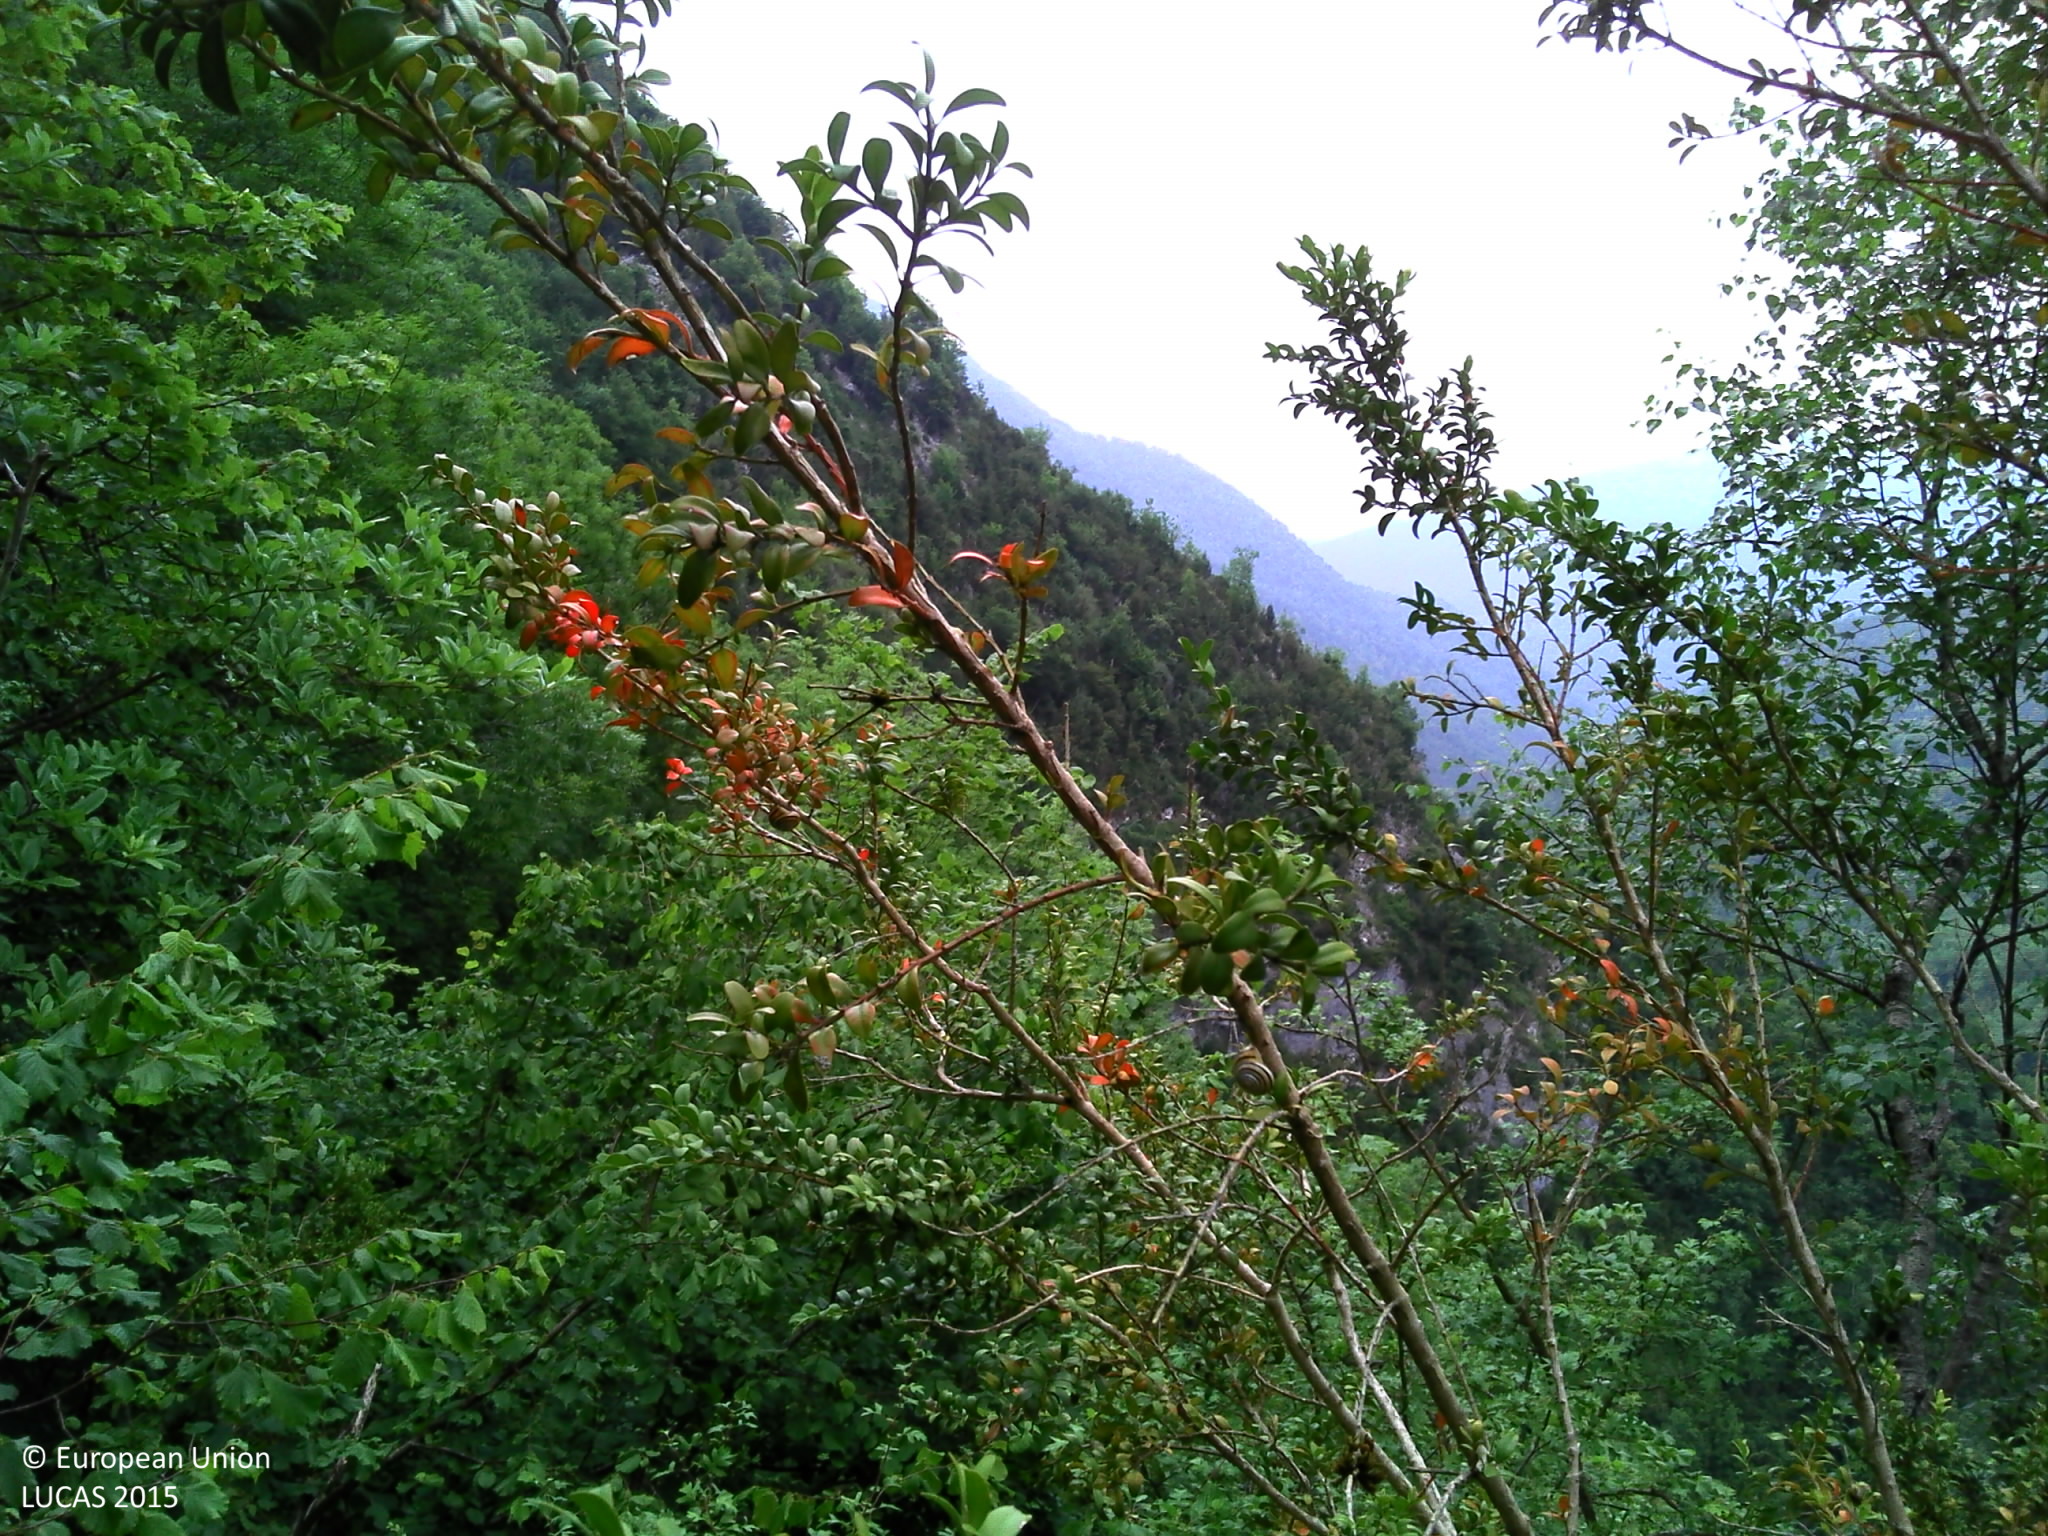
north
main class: Woodland
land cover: Broadleaved woodland
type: mountainous beech forest
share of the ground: > 75 %
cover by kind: broadleaved forest trees 50 %, shrubs 30 %, herbaceous plants 10 %, consolidated bare surface 10 %
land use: Semi-natural and natural areas not in use
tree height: > 5 m
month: July
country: FR
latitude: 42.9249
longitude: 0.8023
